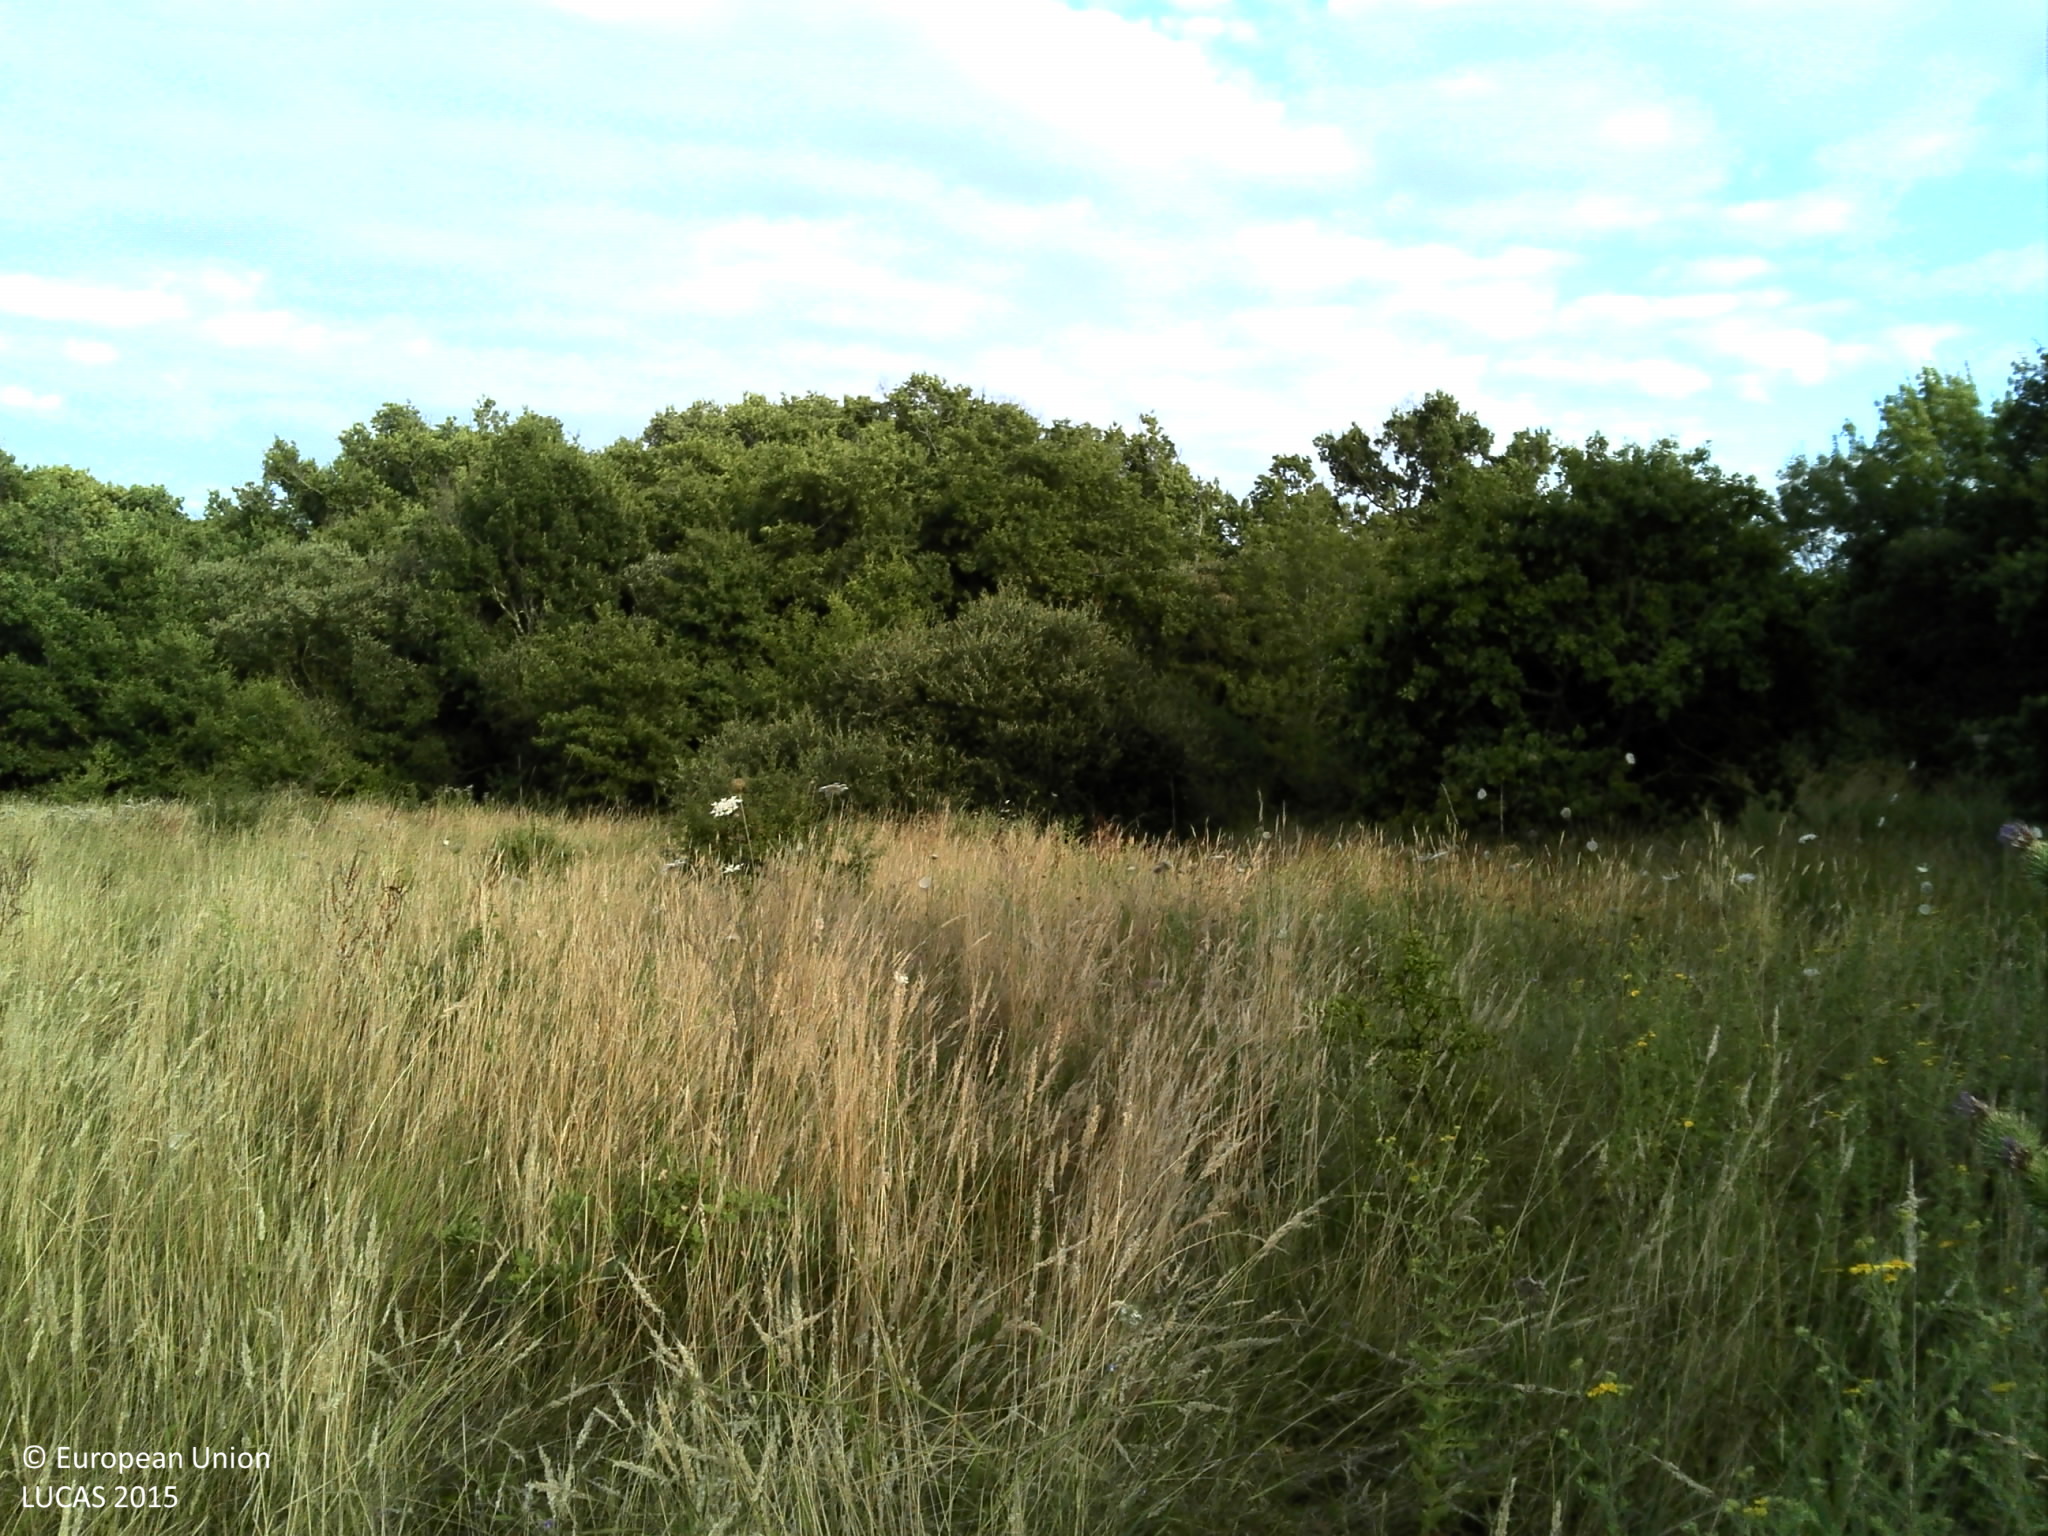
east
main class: Shrubland
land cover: Shrubland without tree cover
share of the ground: > 75 %
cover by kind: herbaceous plants 90 %, shrubs 10 %
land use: Semi-natural and natural areas not in use
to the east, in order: Shrubland without tree cover; Broadleaved woodland; Ditches and canals; Broadleaved woodland; Shrubland without tree cover
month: July
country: FR
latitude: 45.4485
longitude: -1.0613
